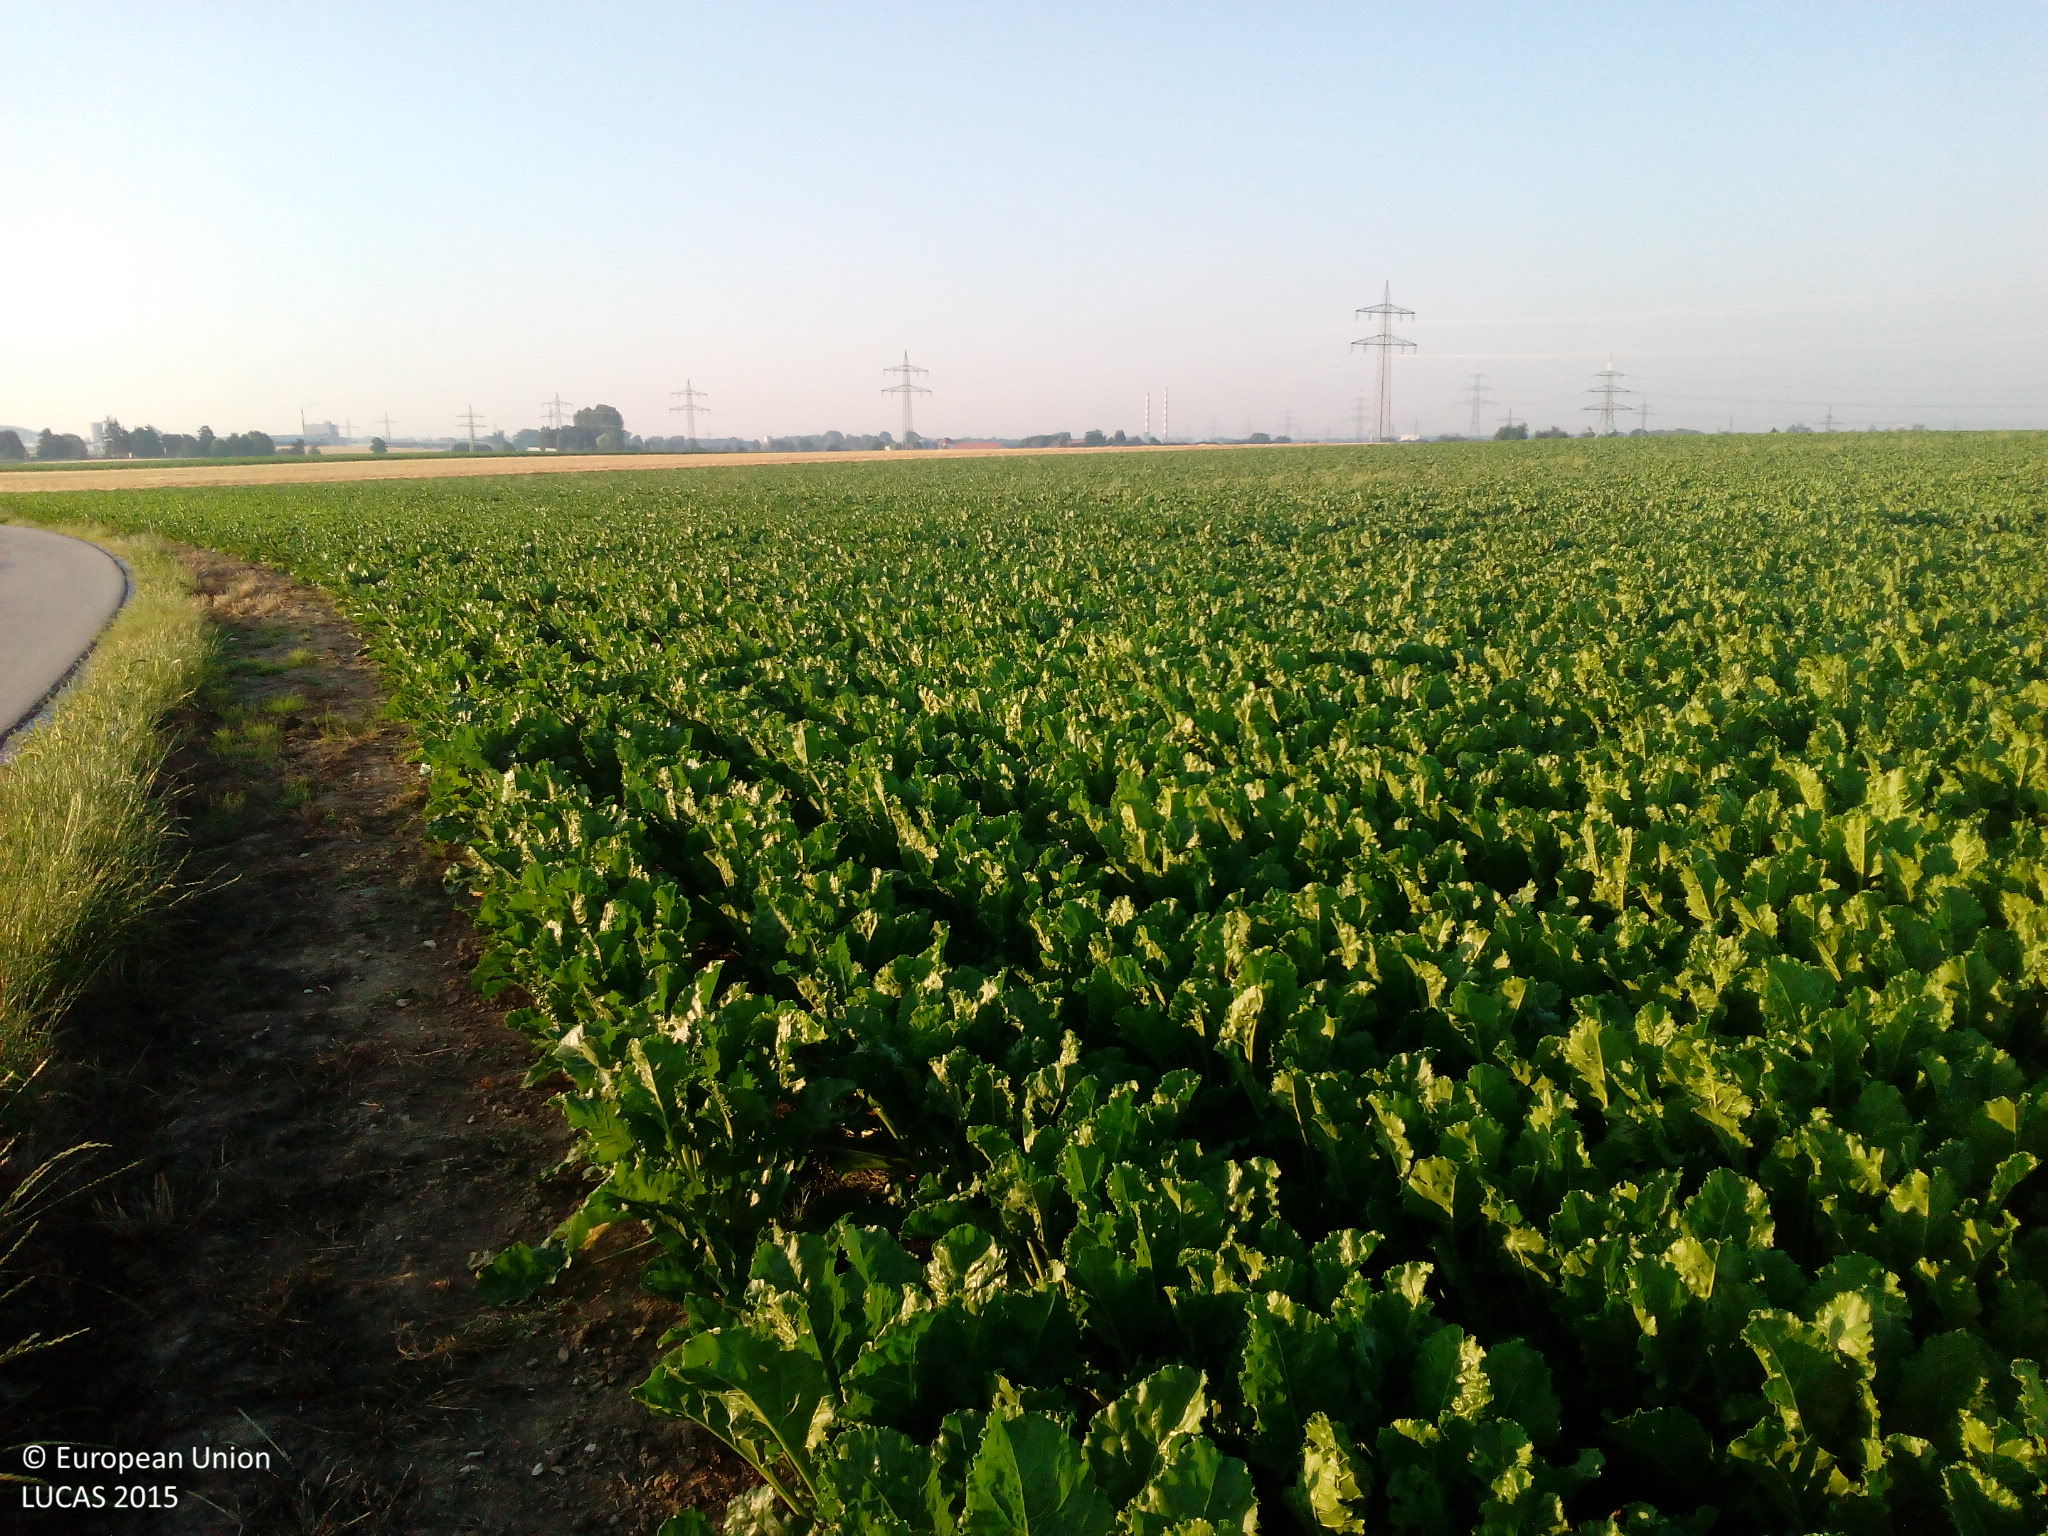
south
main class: Cropland
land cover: Sugar beet
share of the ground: > 75 %
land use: Agriculture (excluding fallow land and kitchen gardens)
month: July
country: DE
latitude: 48.8074
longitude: 11.4836
